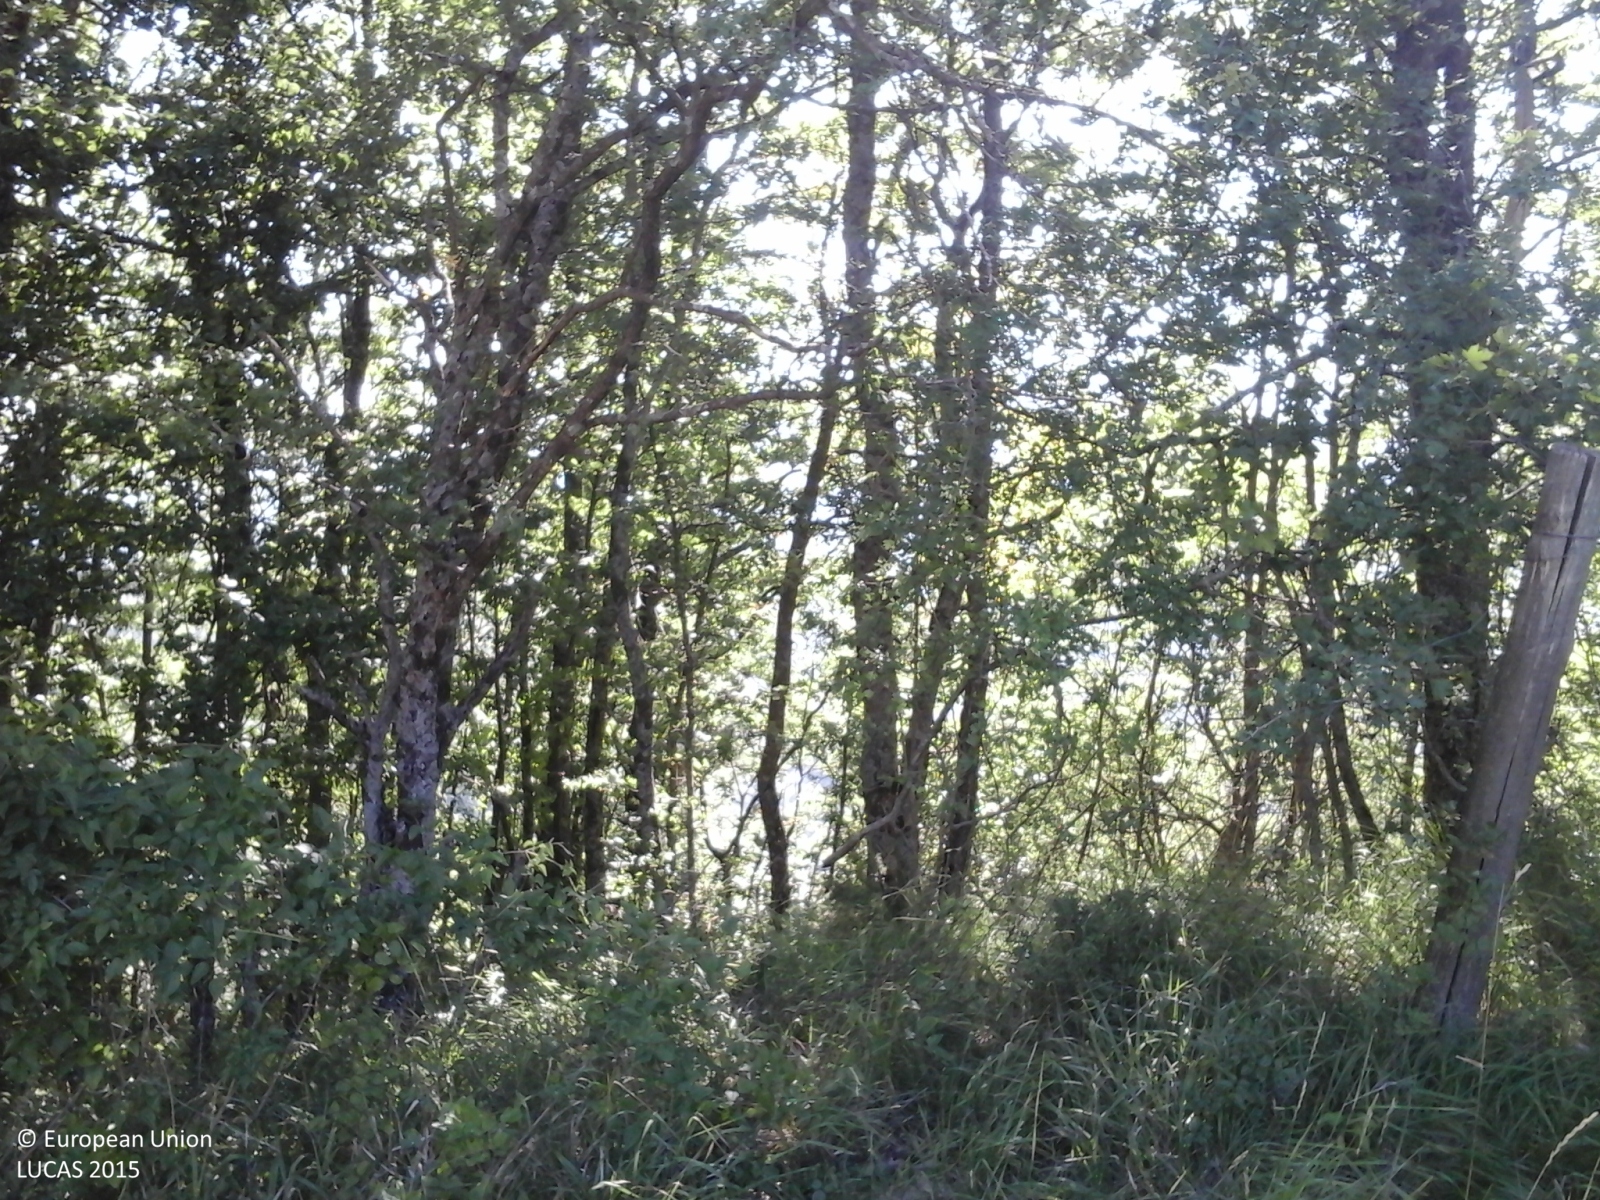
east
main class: Woodland
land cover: Broadleaved woodland
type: thermophilous deciduous forest
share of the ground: > 75 %
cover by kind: broadleaved forest trees 100 %
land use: Forestry
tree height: > 5 m
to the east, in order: Broadleaved woodland; Rocks and stones; Broadleaved woodland; Rocks and stones; Broadleaved woodland
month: July
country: IT
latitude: 44.2404
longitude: 10.6371
